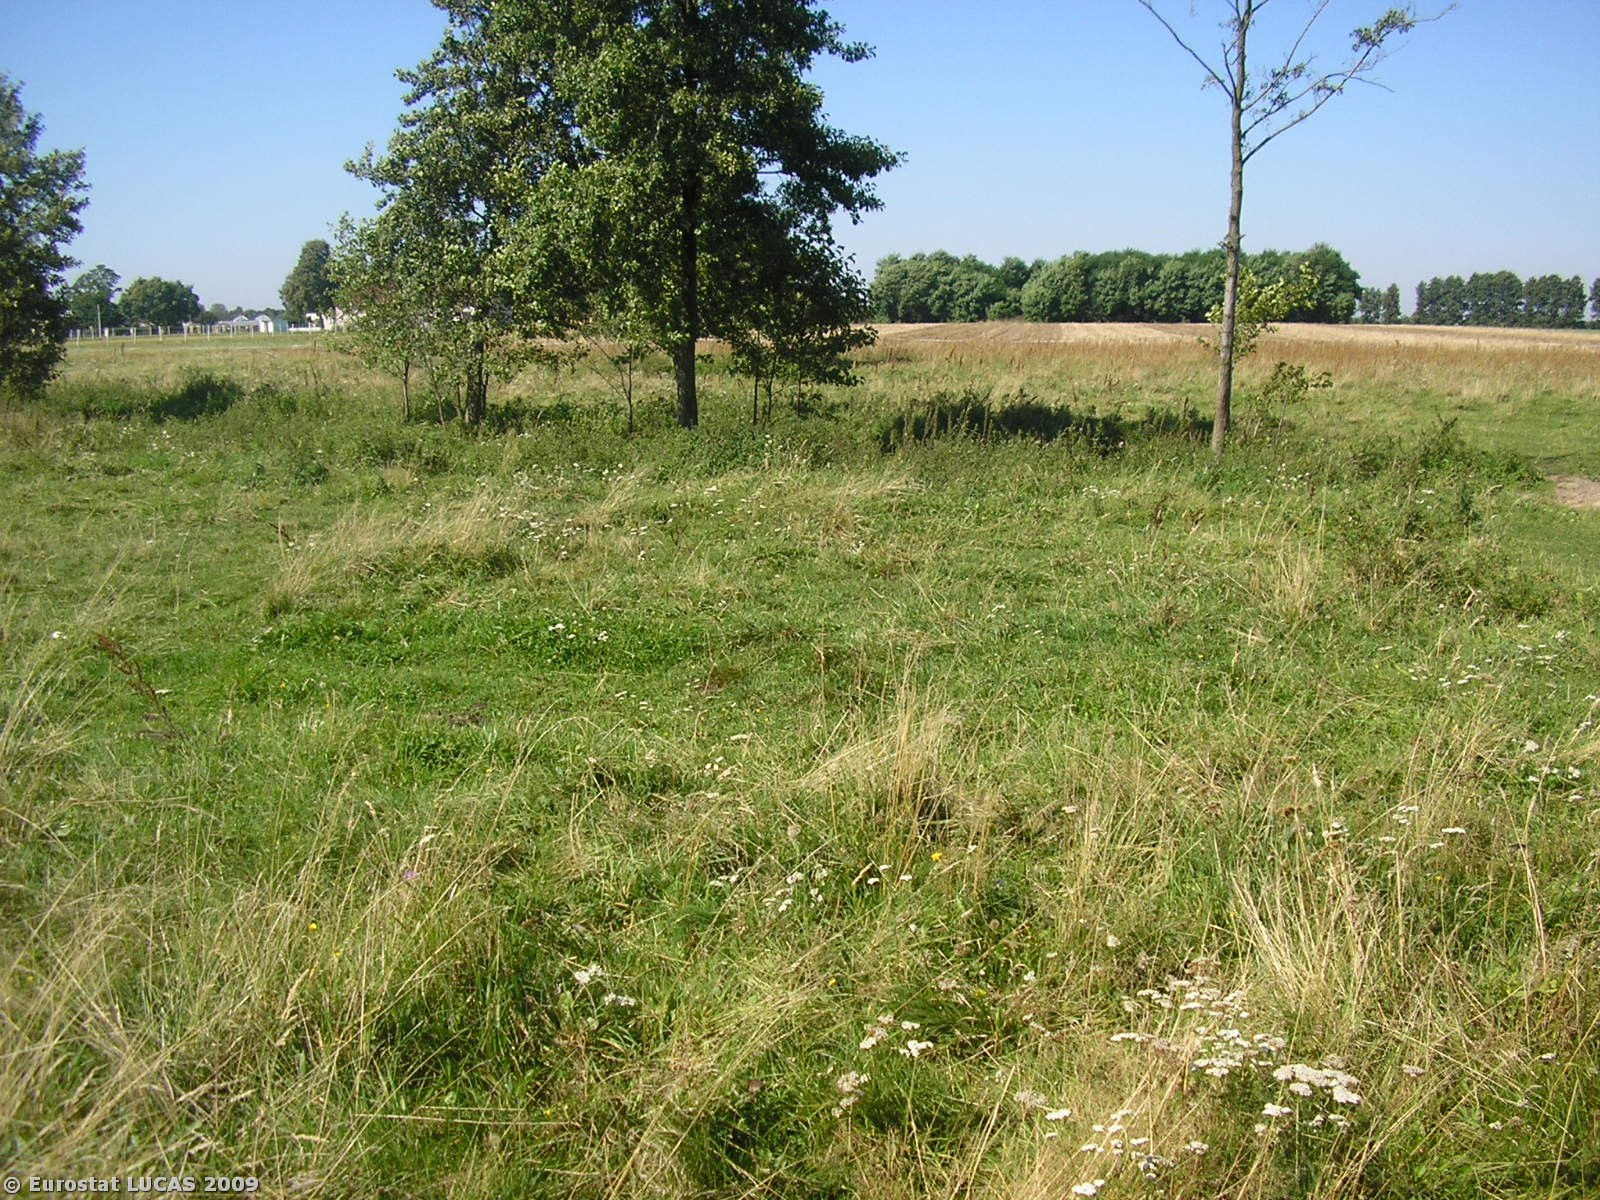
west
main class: Grassland
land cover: Grassland without tree/shrub cover
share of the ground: > 75 %
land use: Agriculture (excluding fallow land and kitchen gardens)
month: September
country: PL
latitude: 51.9725
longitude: 19.5631
